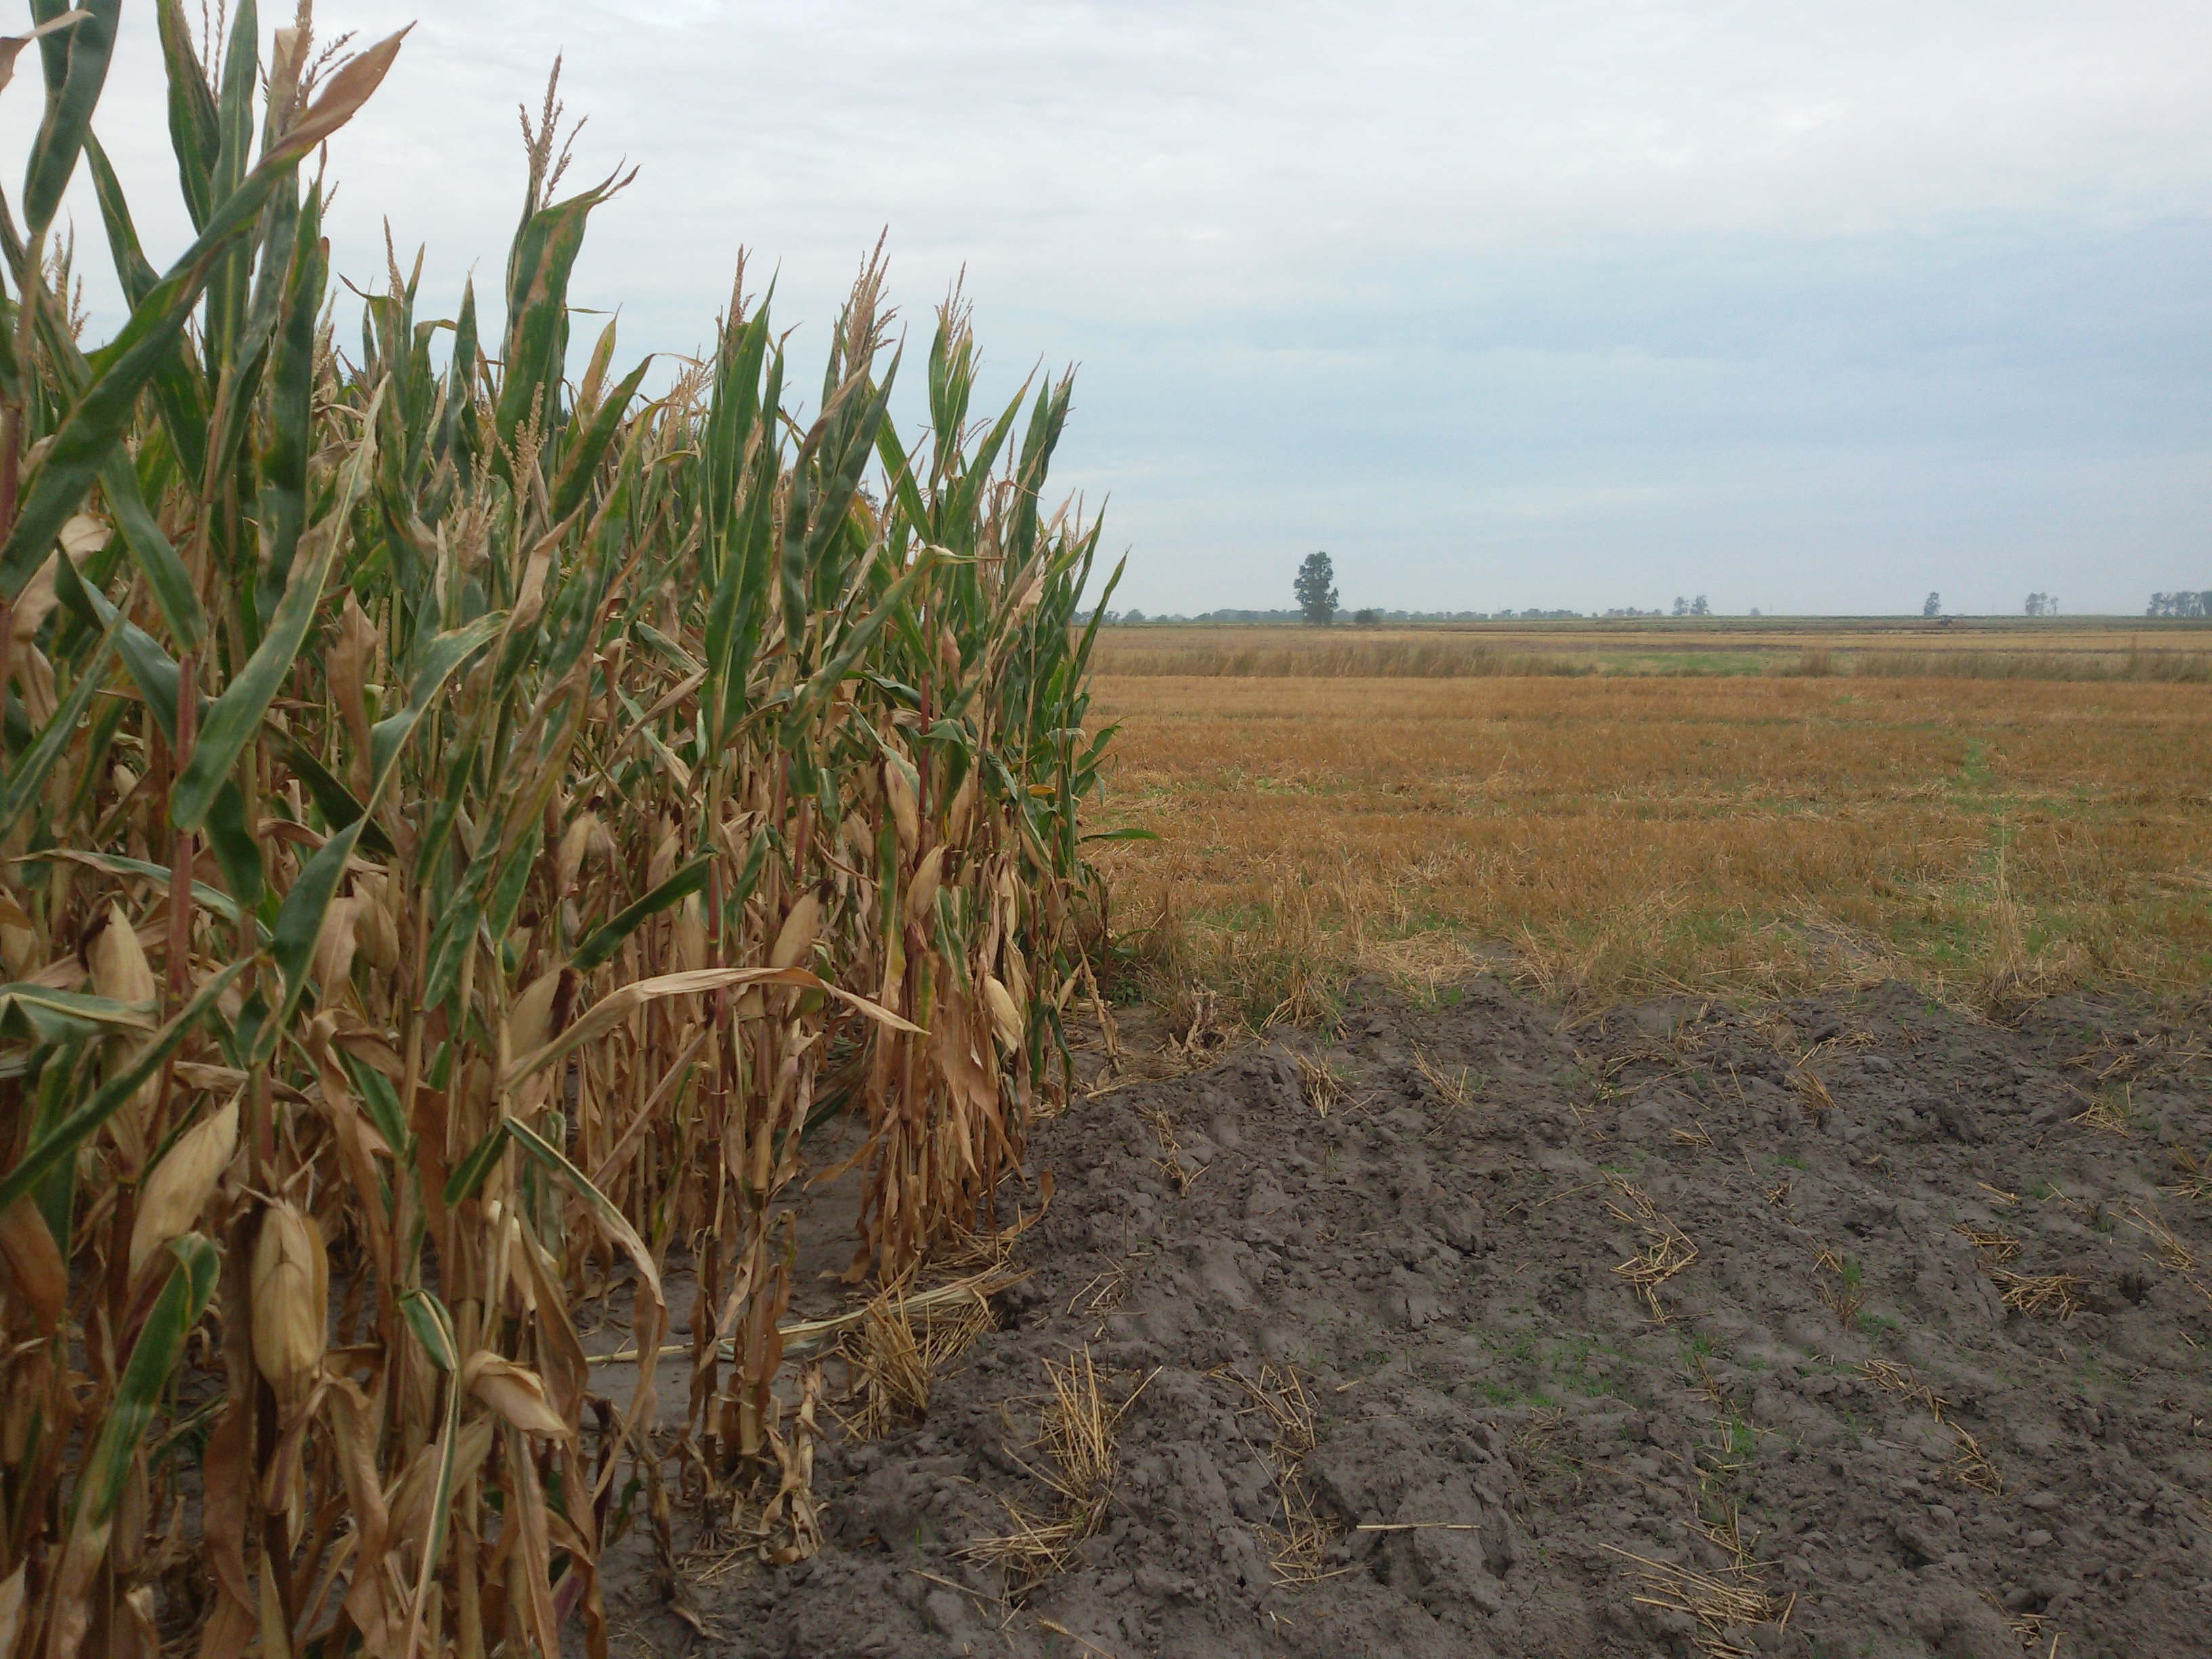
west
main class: Cropland
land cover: Rye
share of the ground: < 10 %
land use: Agriculture (excluding fallow land and kitchen gardens)
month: August
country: PL
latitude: 51.8075
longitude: 17.8905
